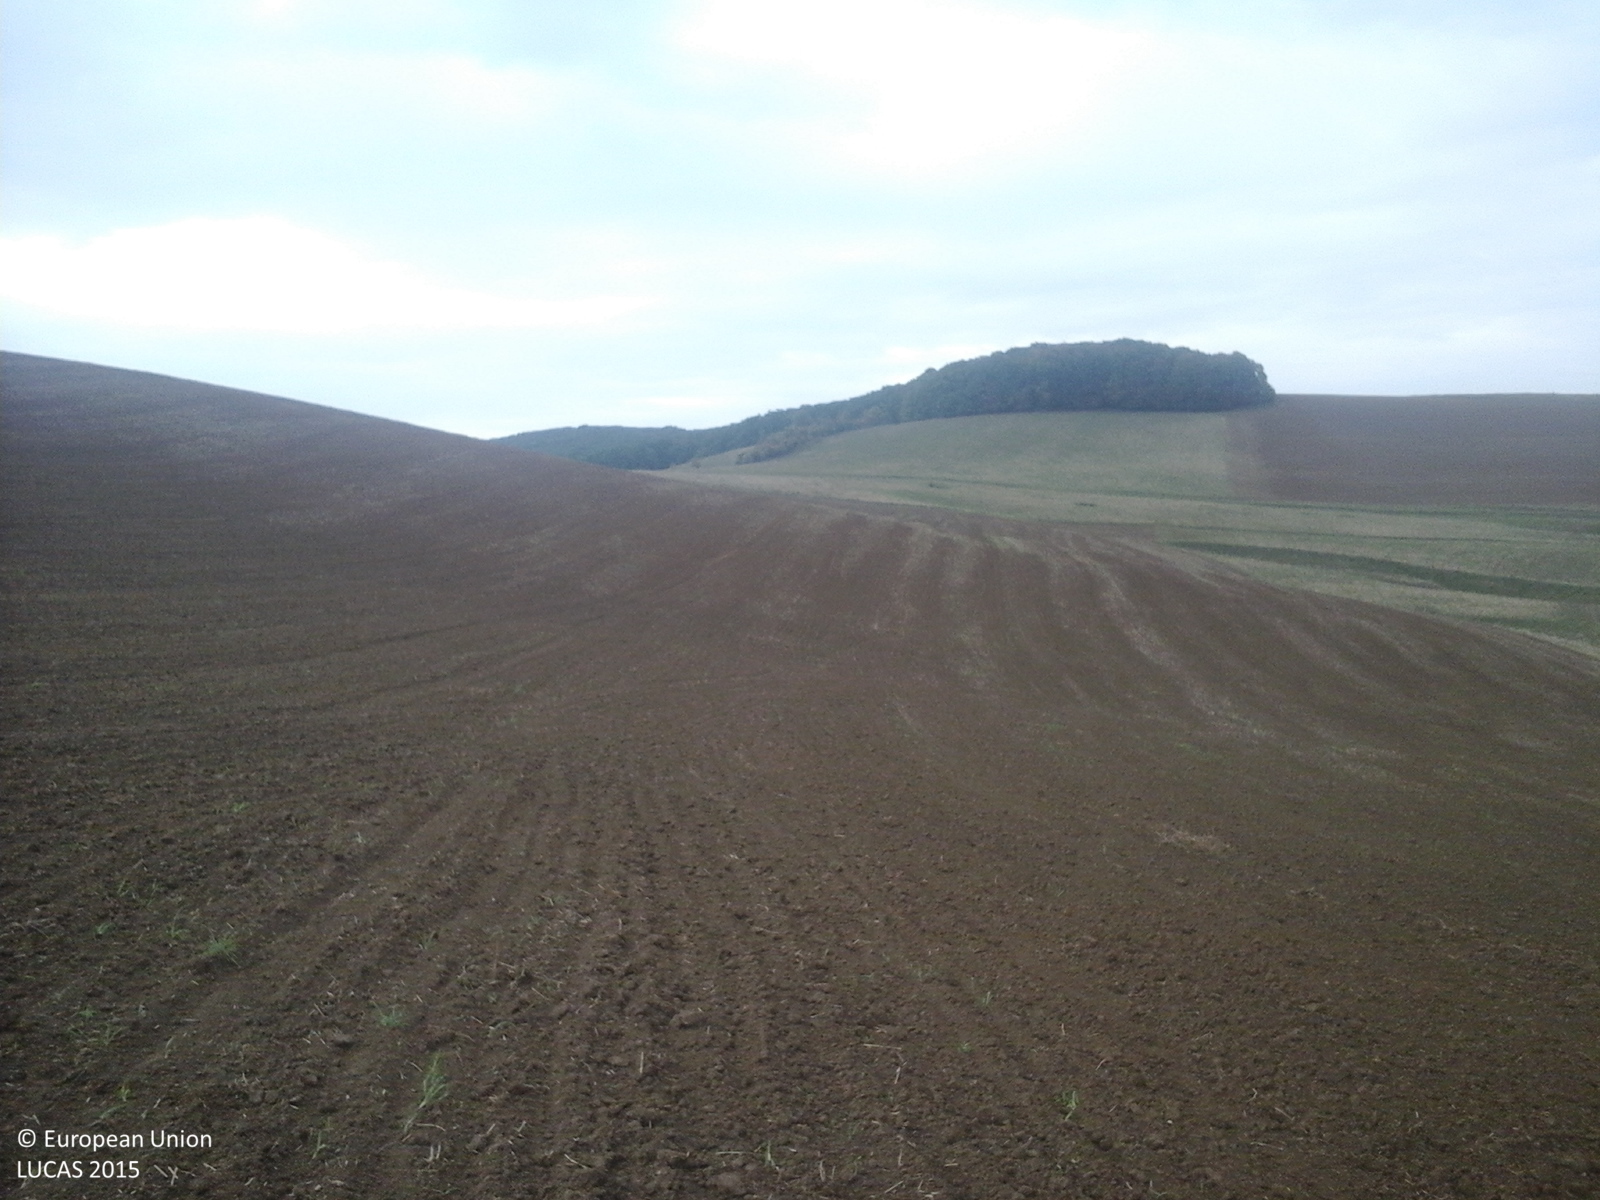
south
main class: Cropland
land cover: Common wheat
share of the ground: 10 - 25 %
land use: Agriculture (excluding fallow land and kitchen gardens)
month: October
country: RO
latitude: 46.4576
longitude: 24.7391
